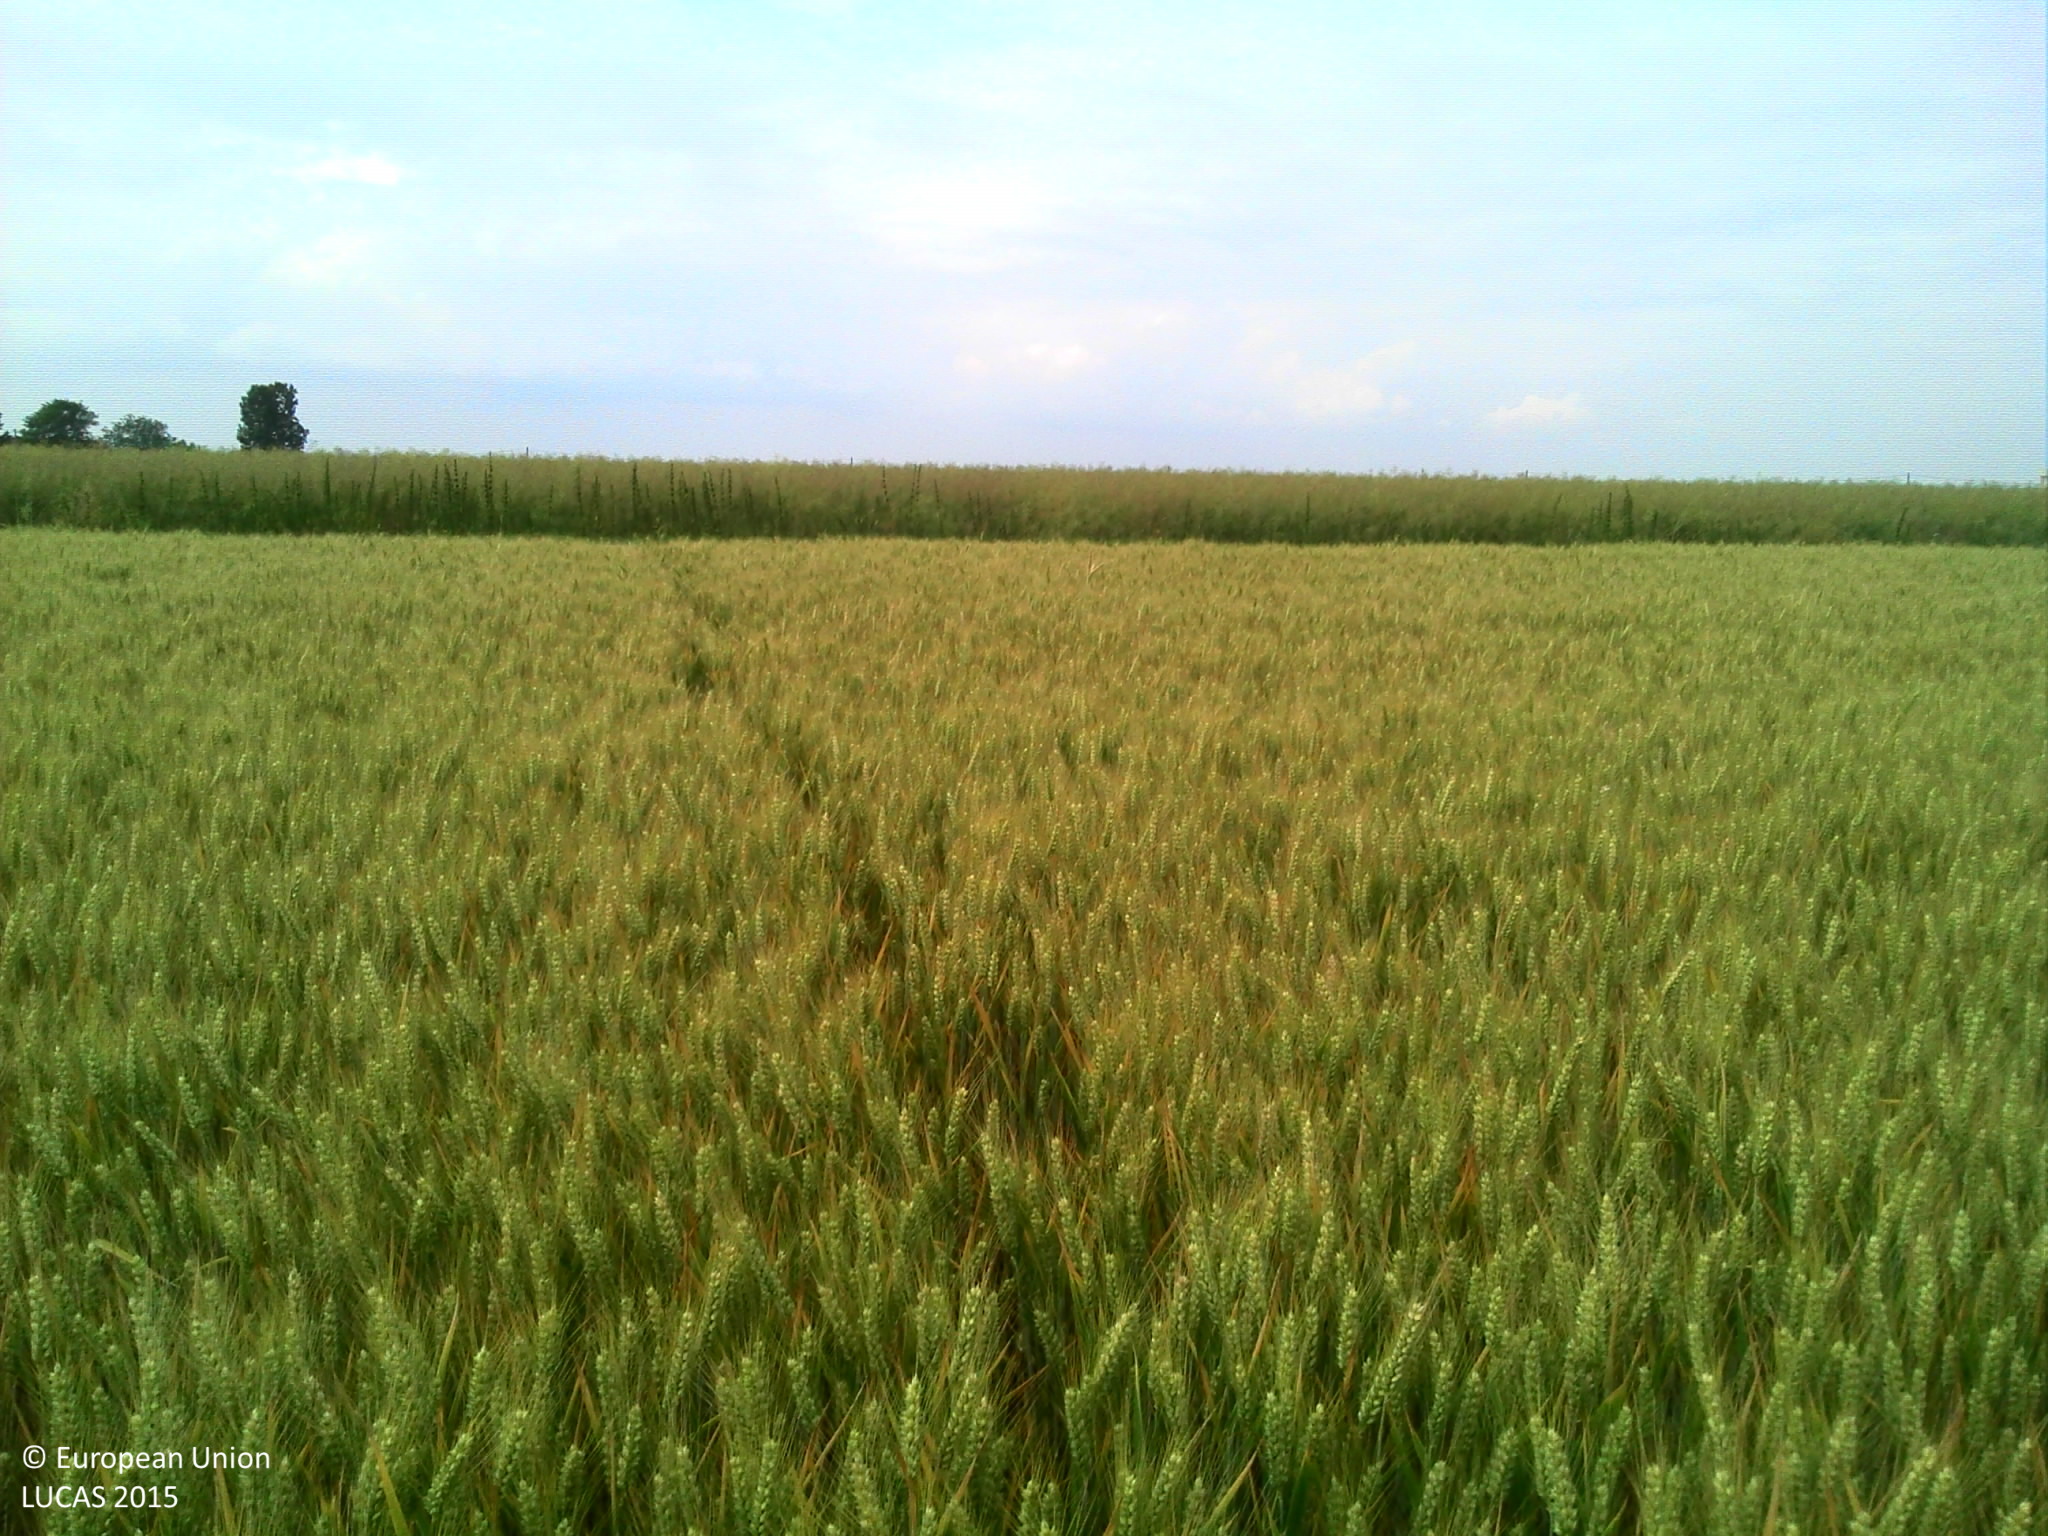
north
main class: Cropland
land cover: Common wheat
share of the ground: > 75 %
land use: Agriculture (excluding fallow land and kitchen gardens)
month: June
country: FR
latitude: 47.0237
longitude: 5.3044
